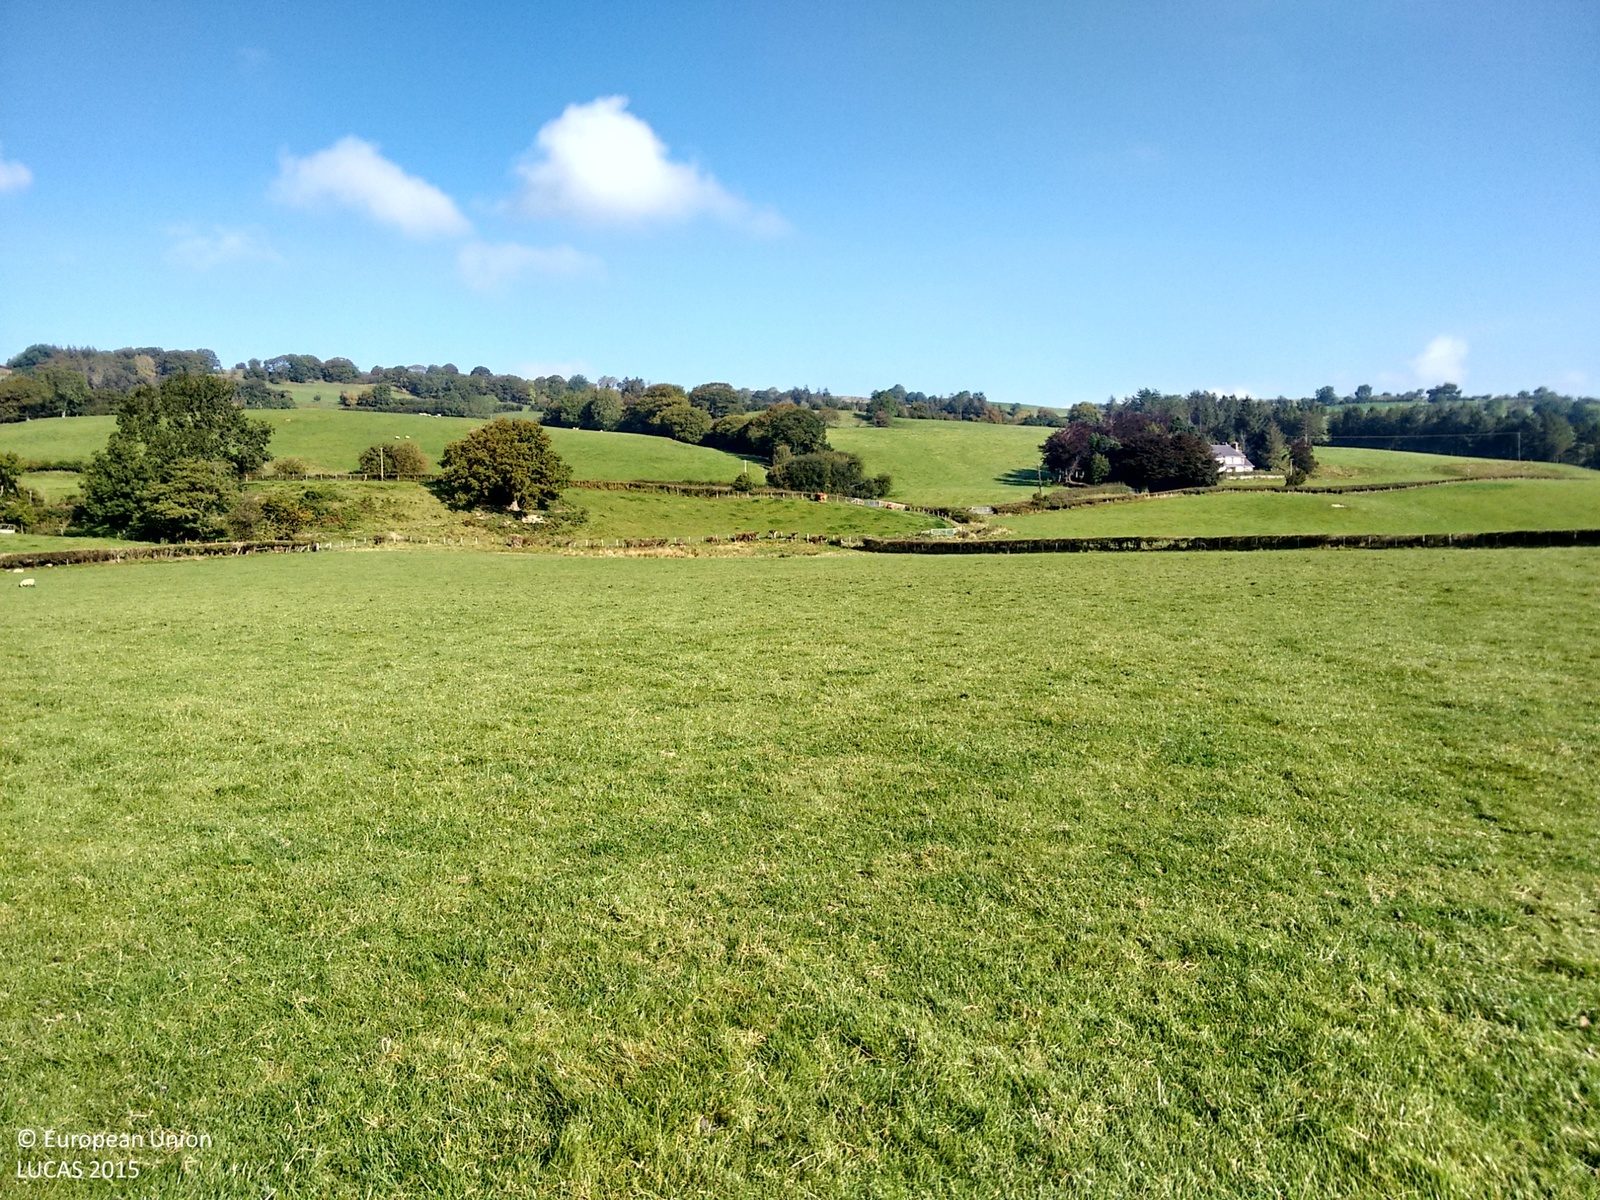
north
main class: Grassland
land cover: Grassland without tree/shrub cover
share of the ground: > 75 %
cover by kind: herbaceous plants 100 %
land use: Agriculture (excluding fallow land and kitchen gardens)
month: October
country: GB
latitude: 52.6878
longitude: -3.4120
